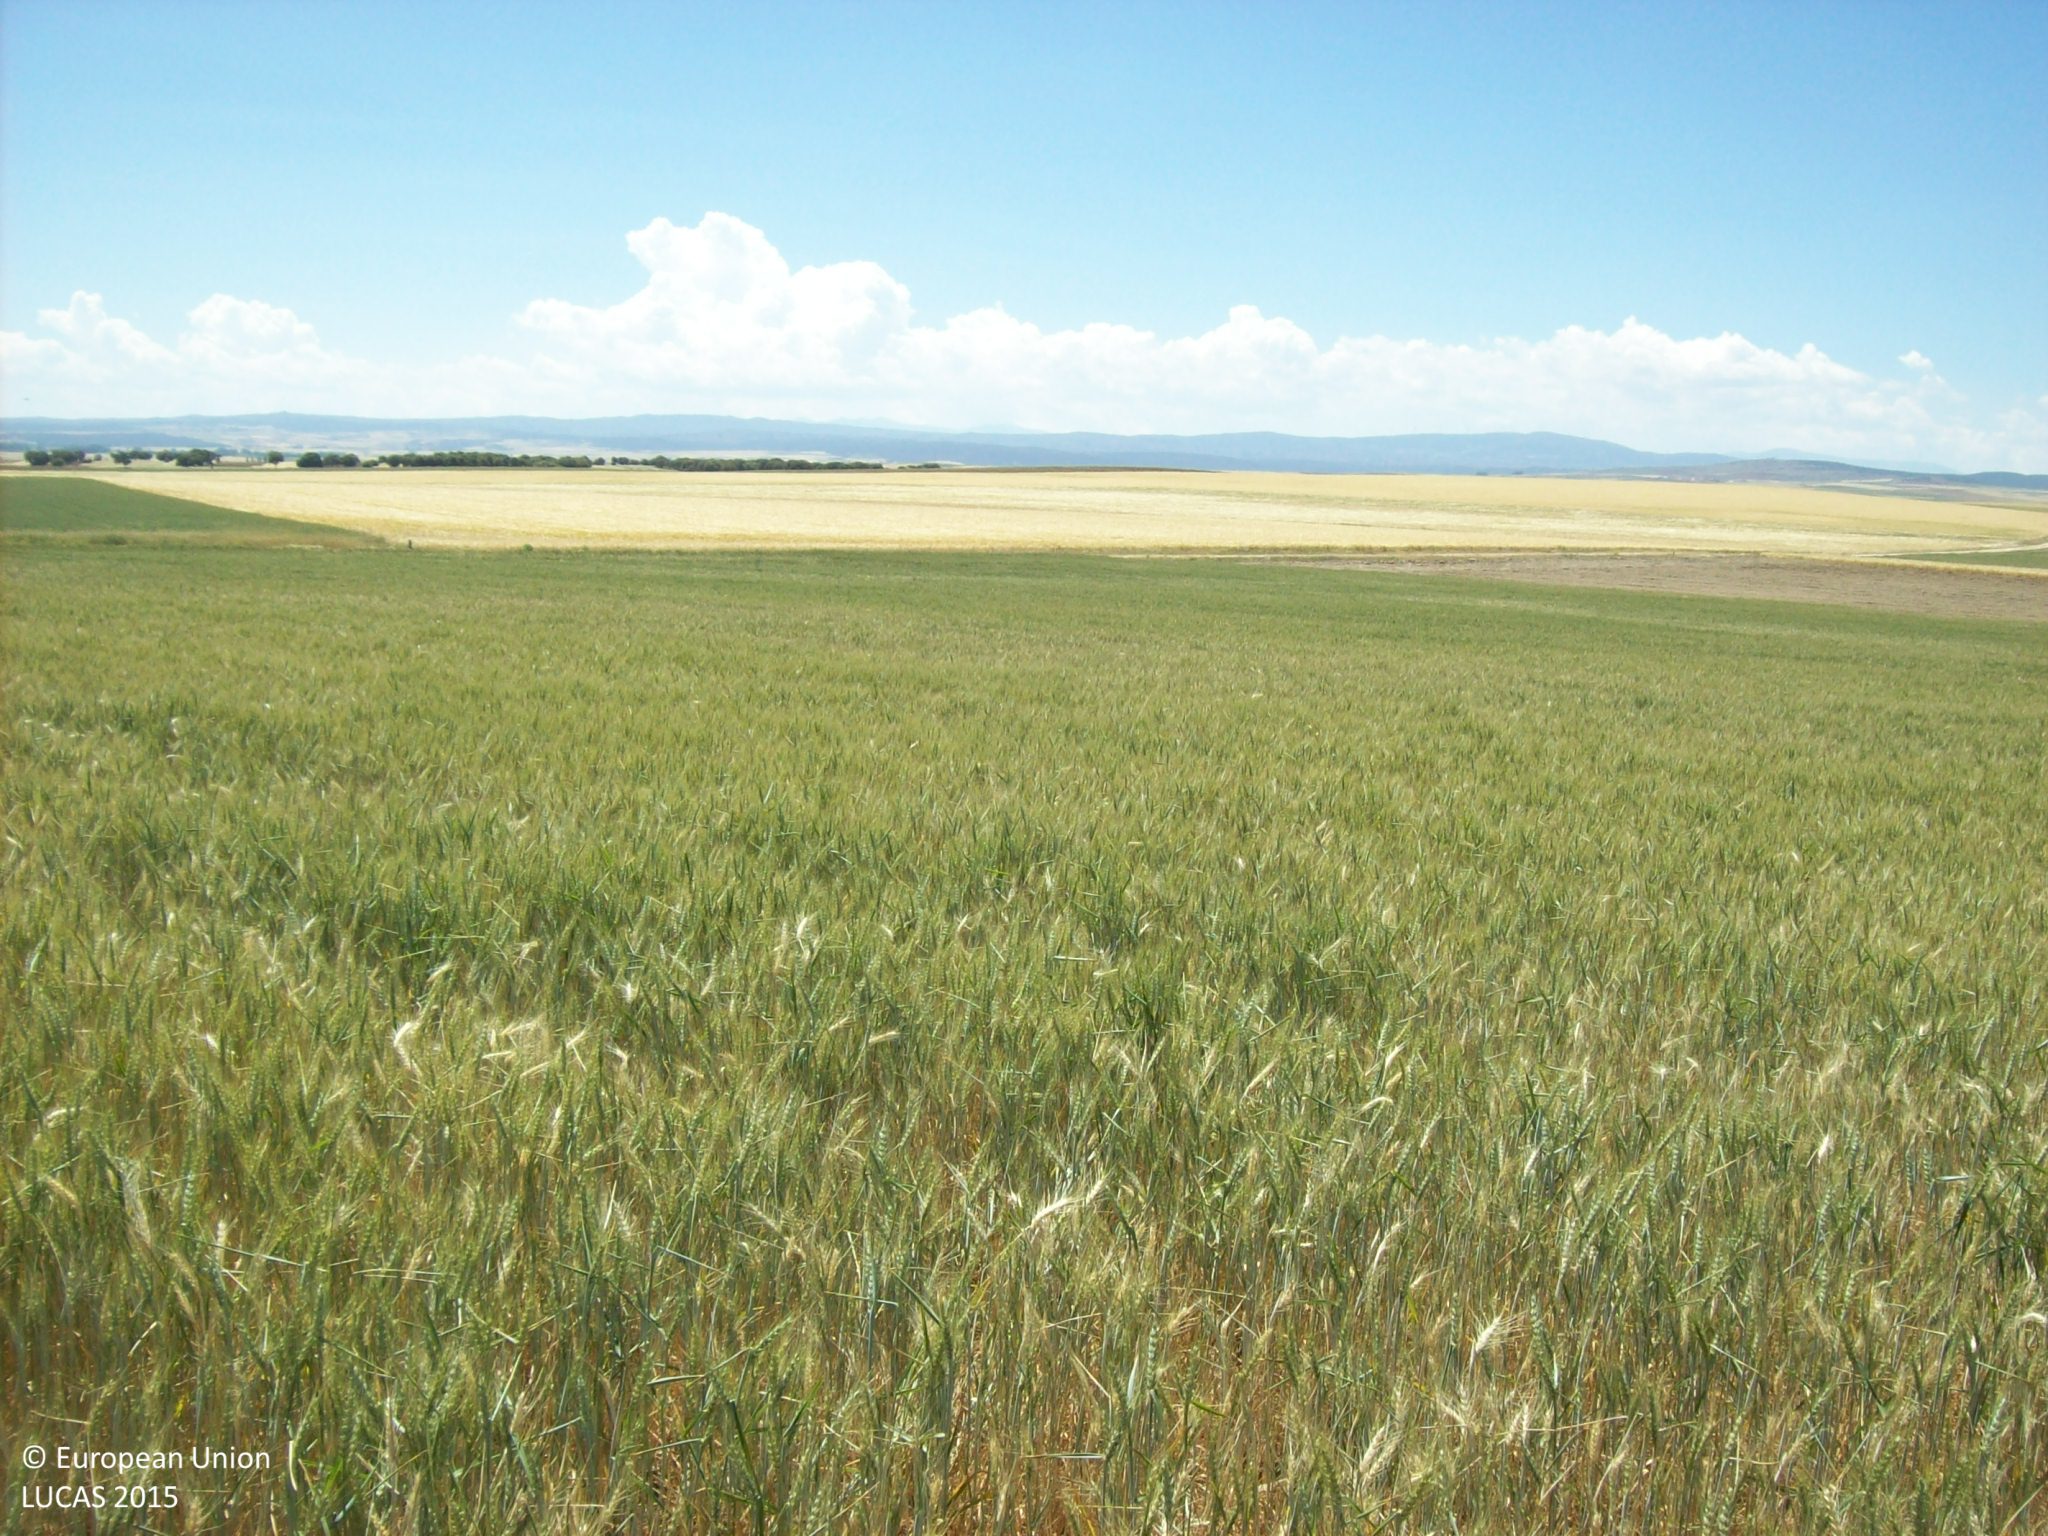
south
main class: Cropland
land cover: Common wheat
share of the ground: > 75 %
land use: Agriculture (excluding fallow land and kitchen gardens)
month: May
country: ES
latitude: 40.8797
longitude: -4.9318
